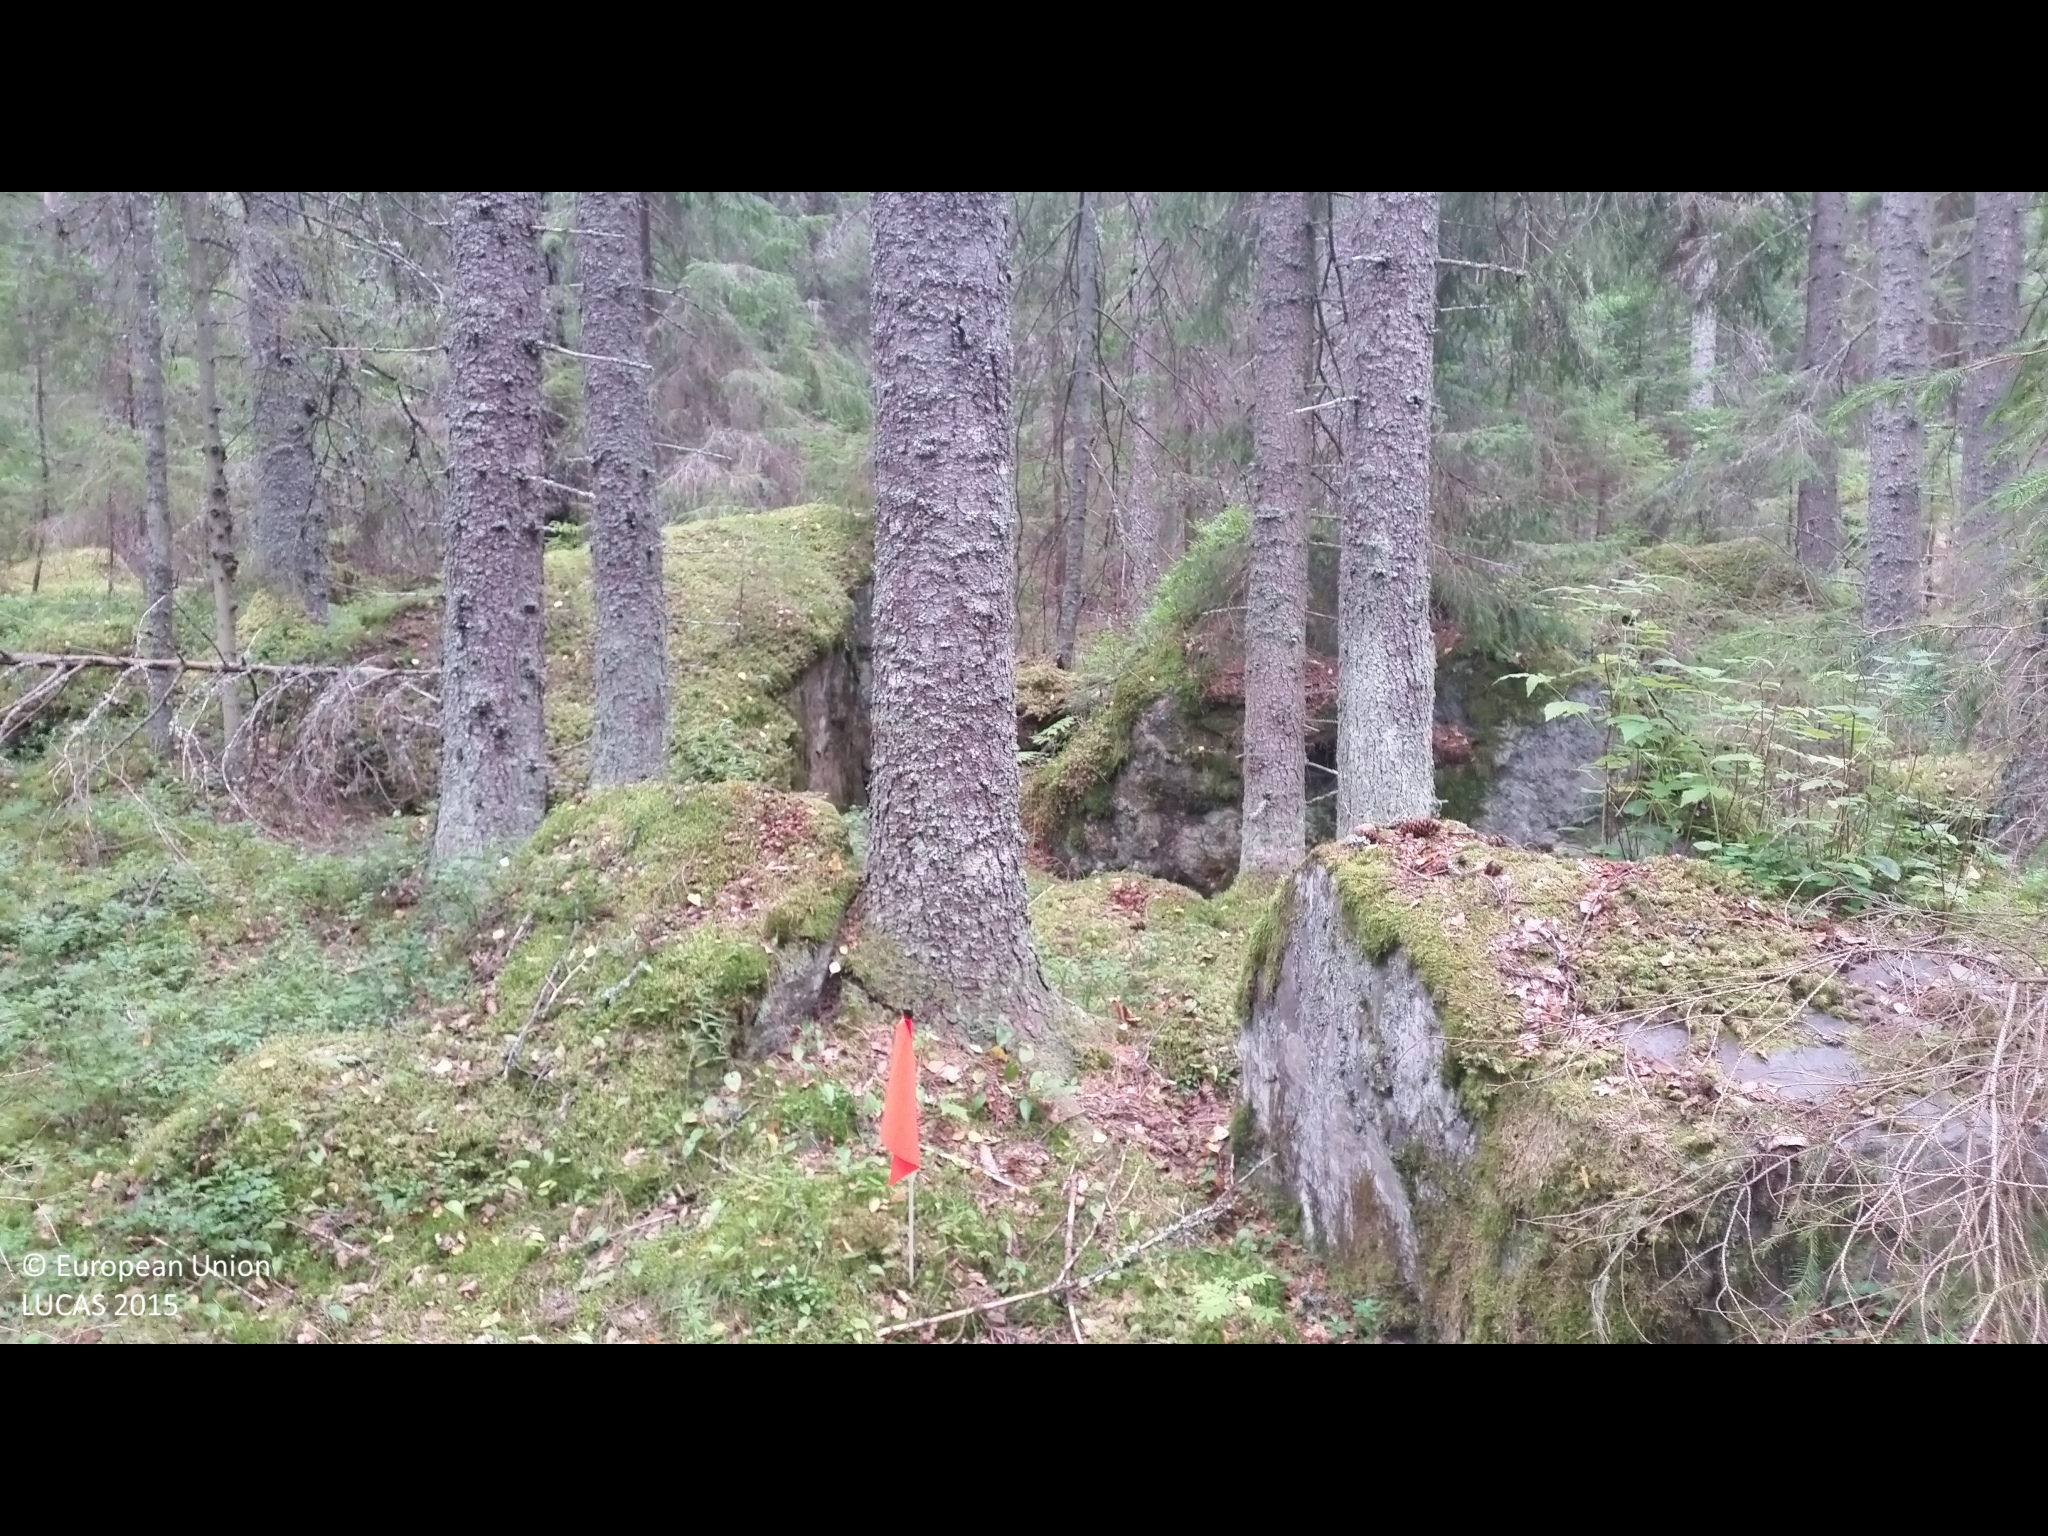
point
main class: Woodland
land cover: Spruce dominated coniferous woodland
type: boreal forest
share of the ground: > 75 %
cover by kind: coniferous forest trees 75 %, lichens and mosses 10 %, shrubs 5 %, herbaceous plants 5 %, consolidated bare surface 5 %
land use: Forestry
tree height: > 5 m
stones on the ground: < 10 %
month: August
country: SE
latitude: 60.8620
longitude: 17.2608
